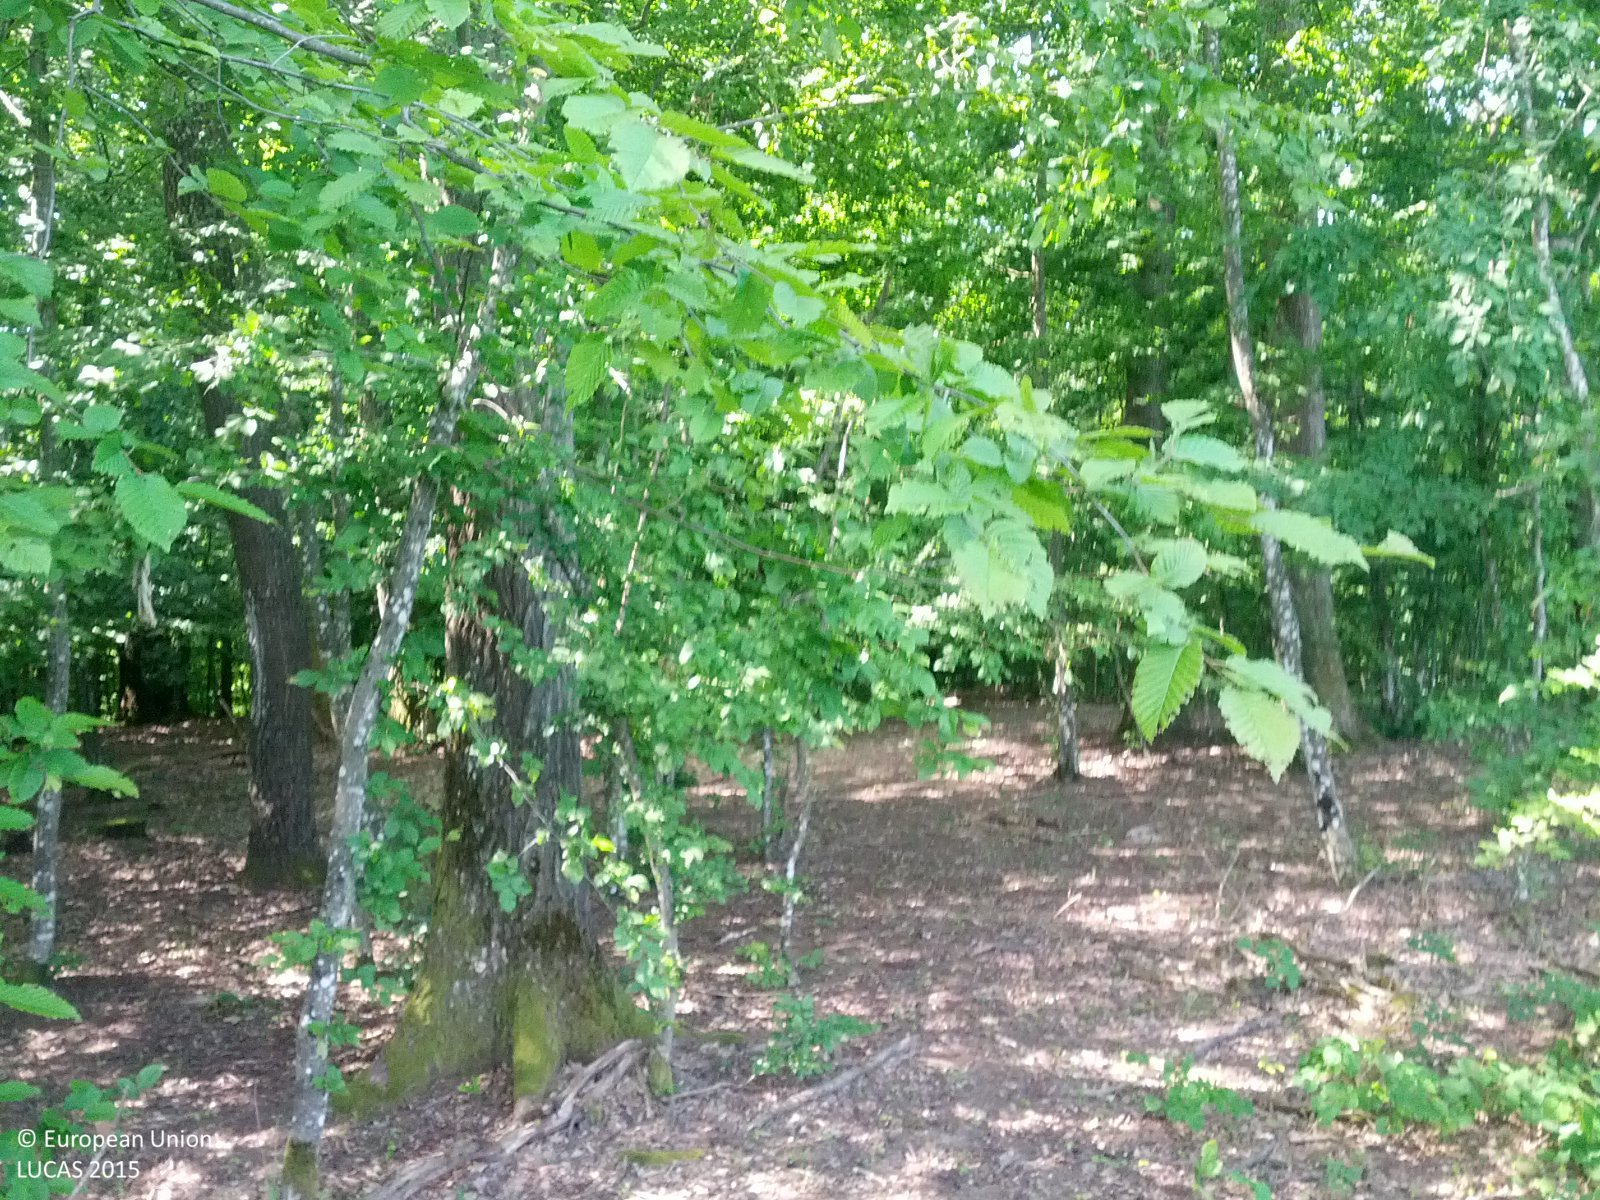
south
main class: Woodland
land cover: Broadleaved woodland
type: beech forest
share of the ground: 50 - 75 %
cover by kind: broadleaved forest trees 60 %, unconsolidated bare surface 20 %, herbaceous plants 15 %, shrubs 5 %
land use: Forestry
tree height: > 5 m
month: June
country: AT
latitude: 47.0992
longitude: 16.3925
